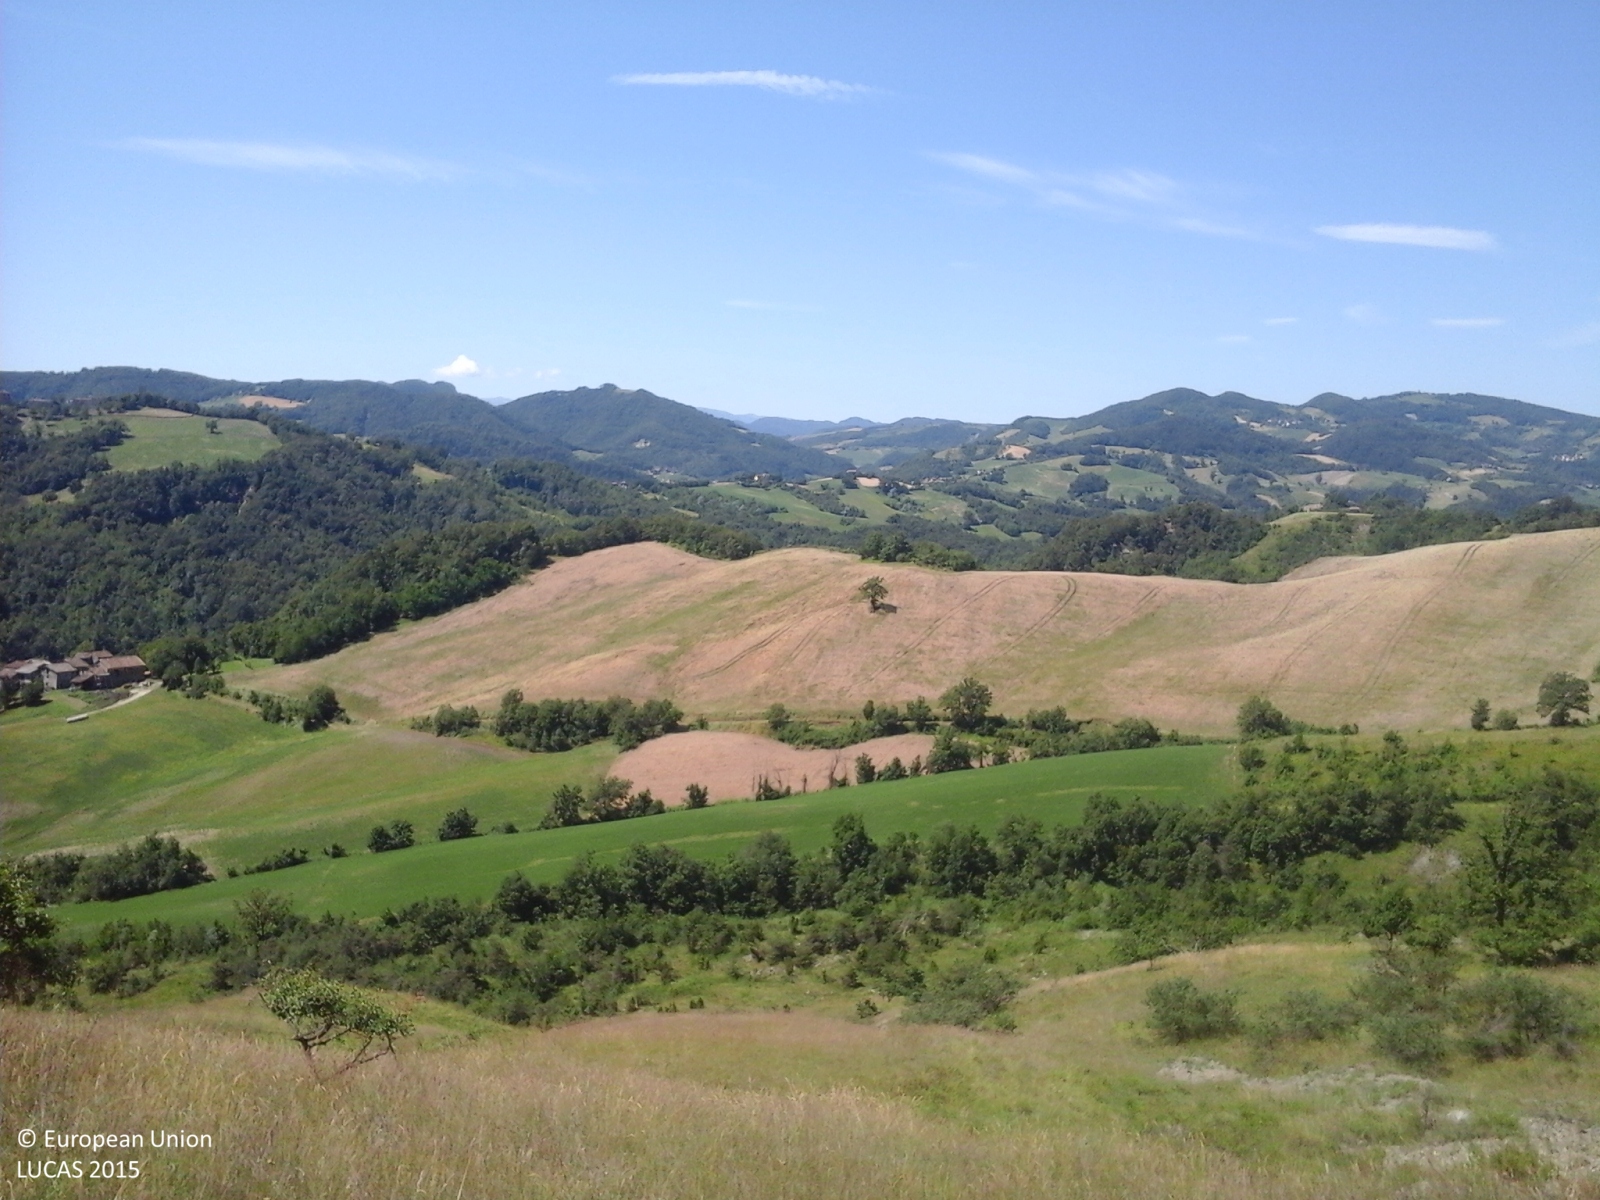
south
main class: Grassland
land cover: Grassland without tree/shrub cover
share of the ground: > 75 %
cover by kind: herbaceous plants 85 %, consolidated bare surface 15 %
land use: Semi-natural and natural areas not in use
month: June
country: IT
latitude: 44.5650
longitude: 10.6407
